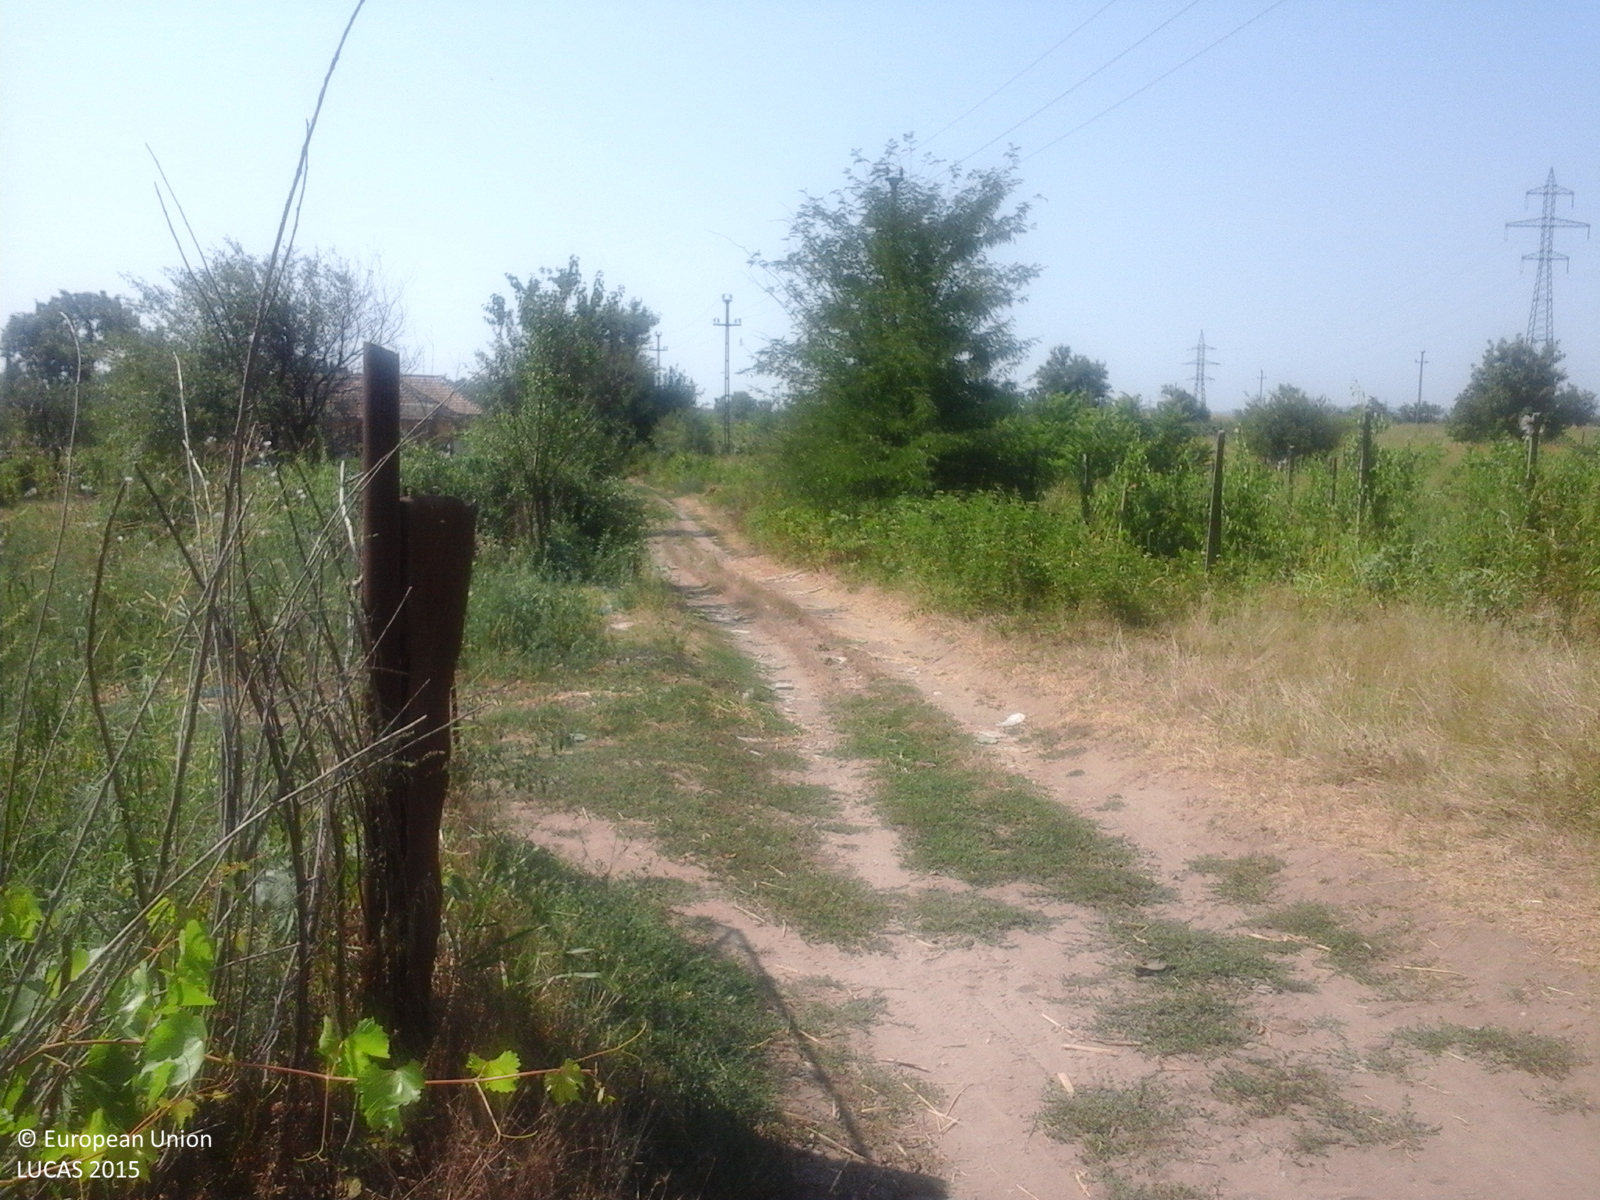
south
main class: Cropland
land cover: Vineyards
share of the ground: > 75 %
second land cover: Spontaneously vegetated surfaces
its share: 25 - 50 %
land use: Agriculture (excluding fallow land and kitchen gardens)
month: August
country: RO
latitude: 44.2141
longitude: 22.9210
